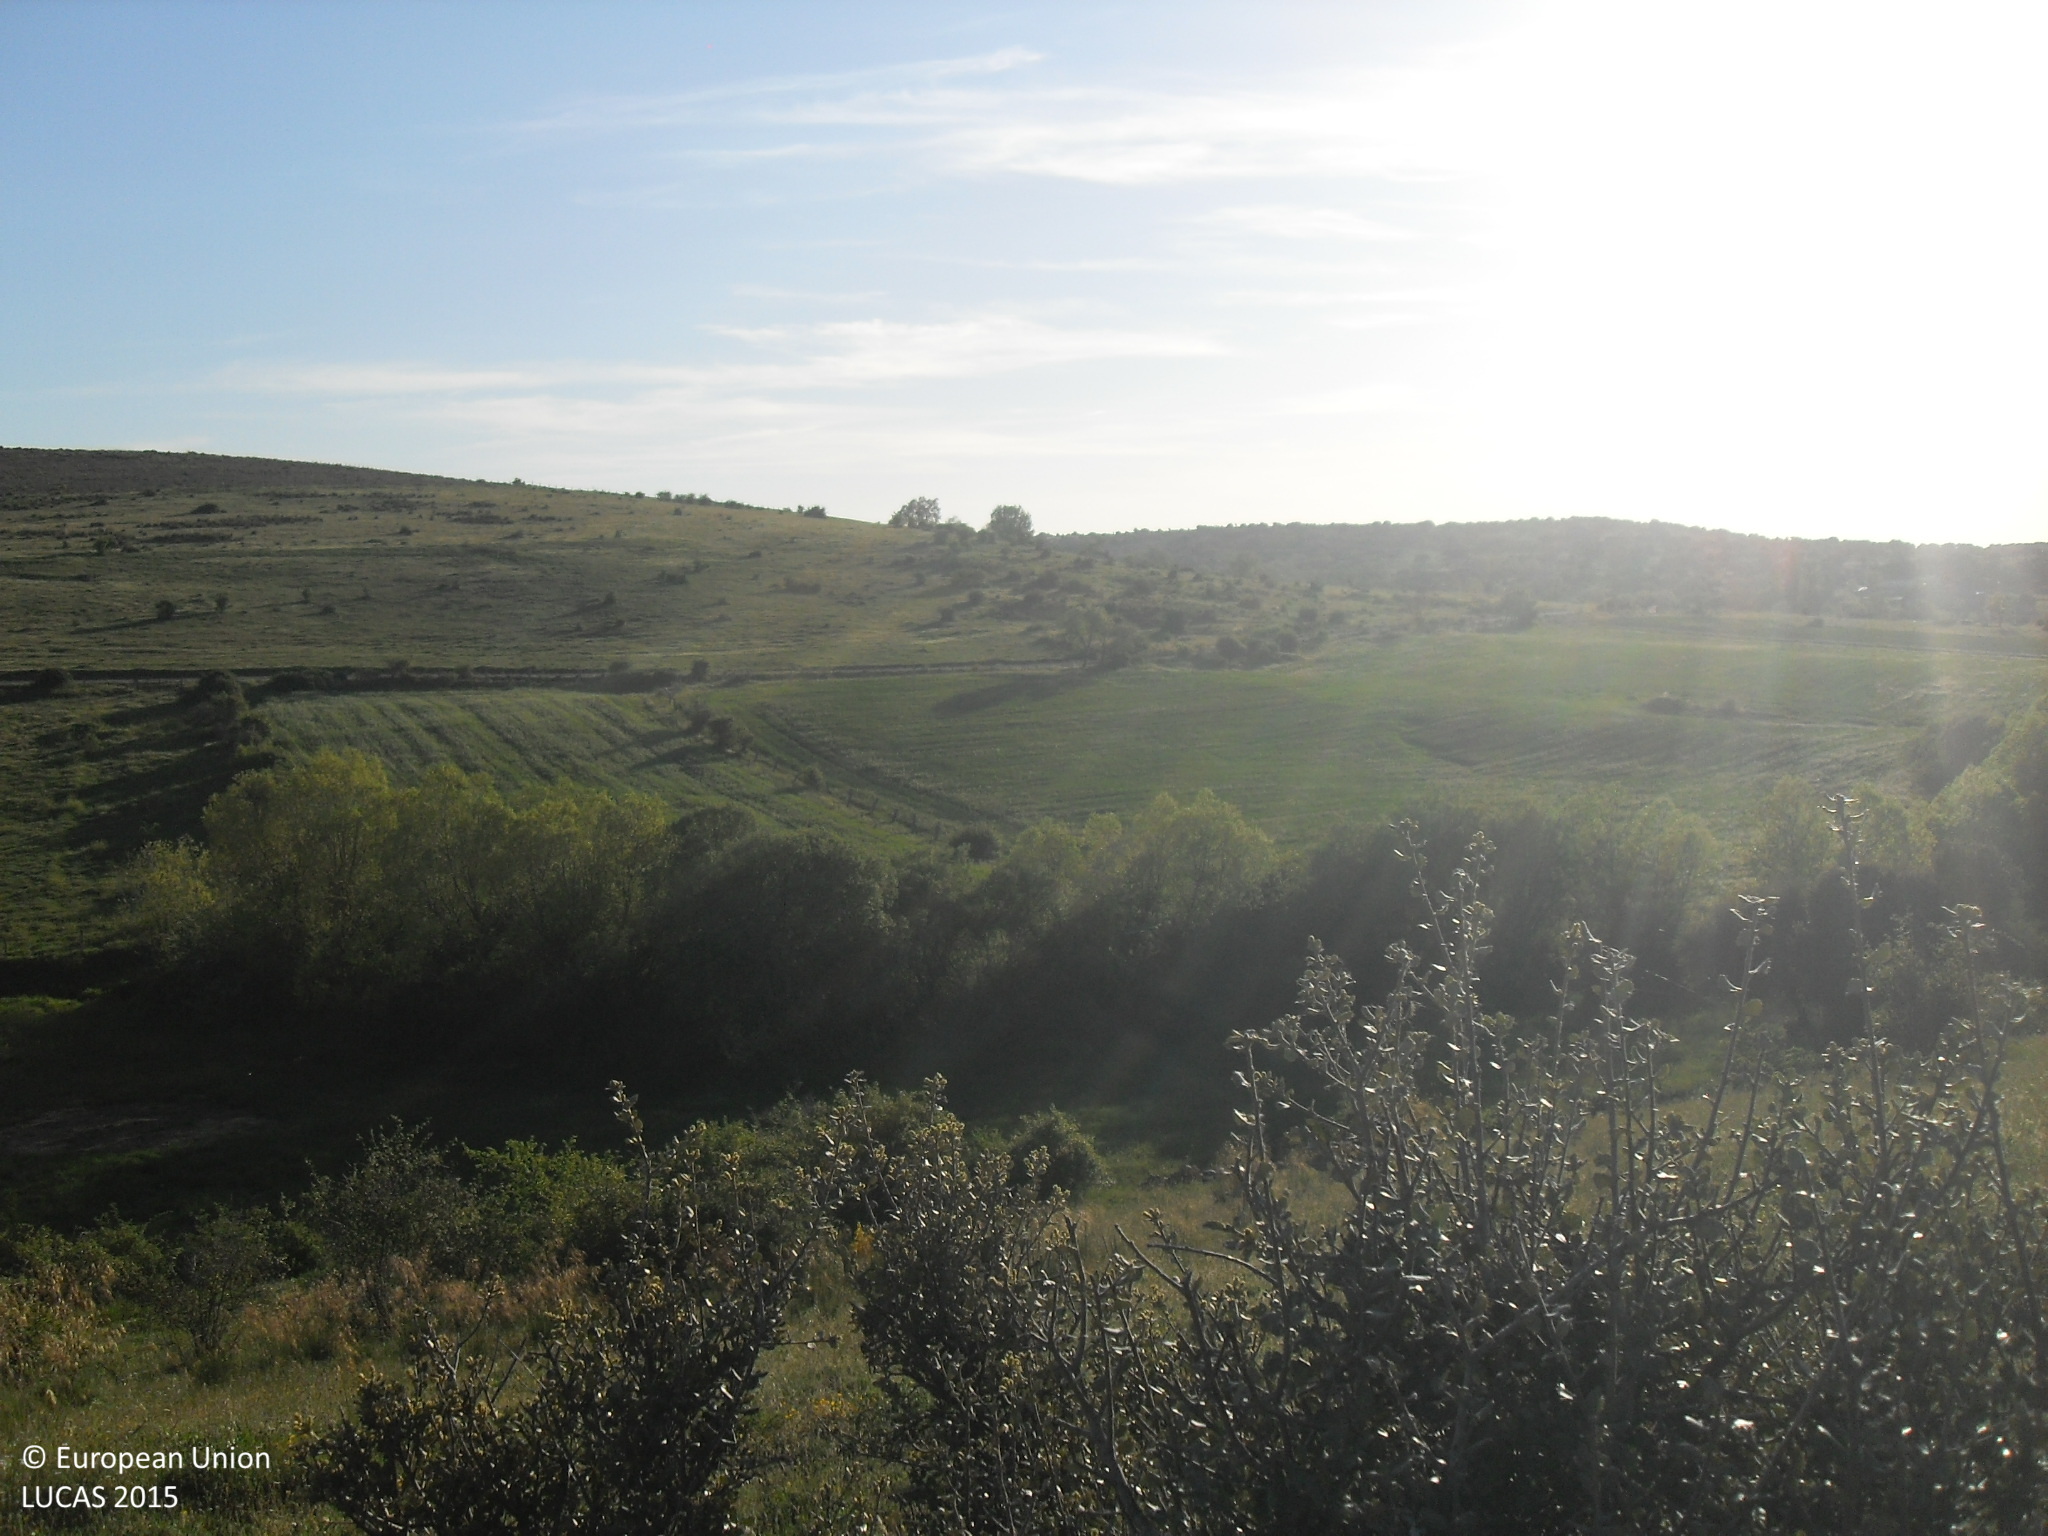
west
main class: Grassland
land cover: Grassland with sparse tree/shrub cover
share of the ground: > 75 %
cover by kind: herbaceous plants 95 %, broadleaved forest trees 5 %
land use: Agriculture (excluding fallow land and kitchen gardens)
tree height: < 5 m
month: May
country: ES
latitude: 40.6884
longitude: -5.1025
